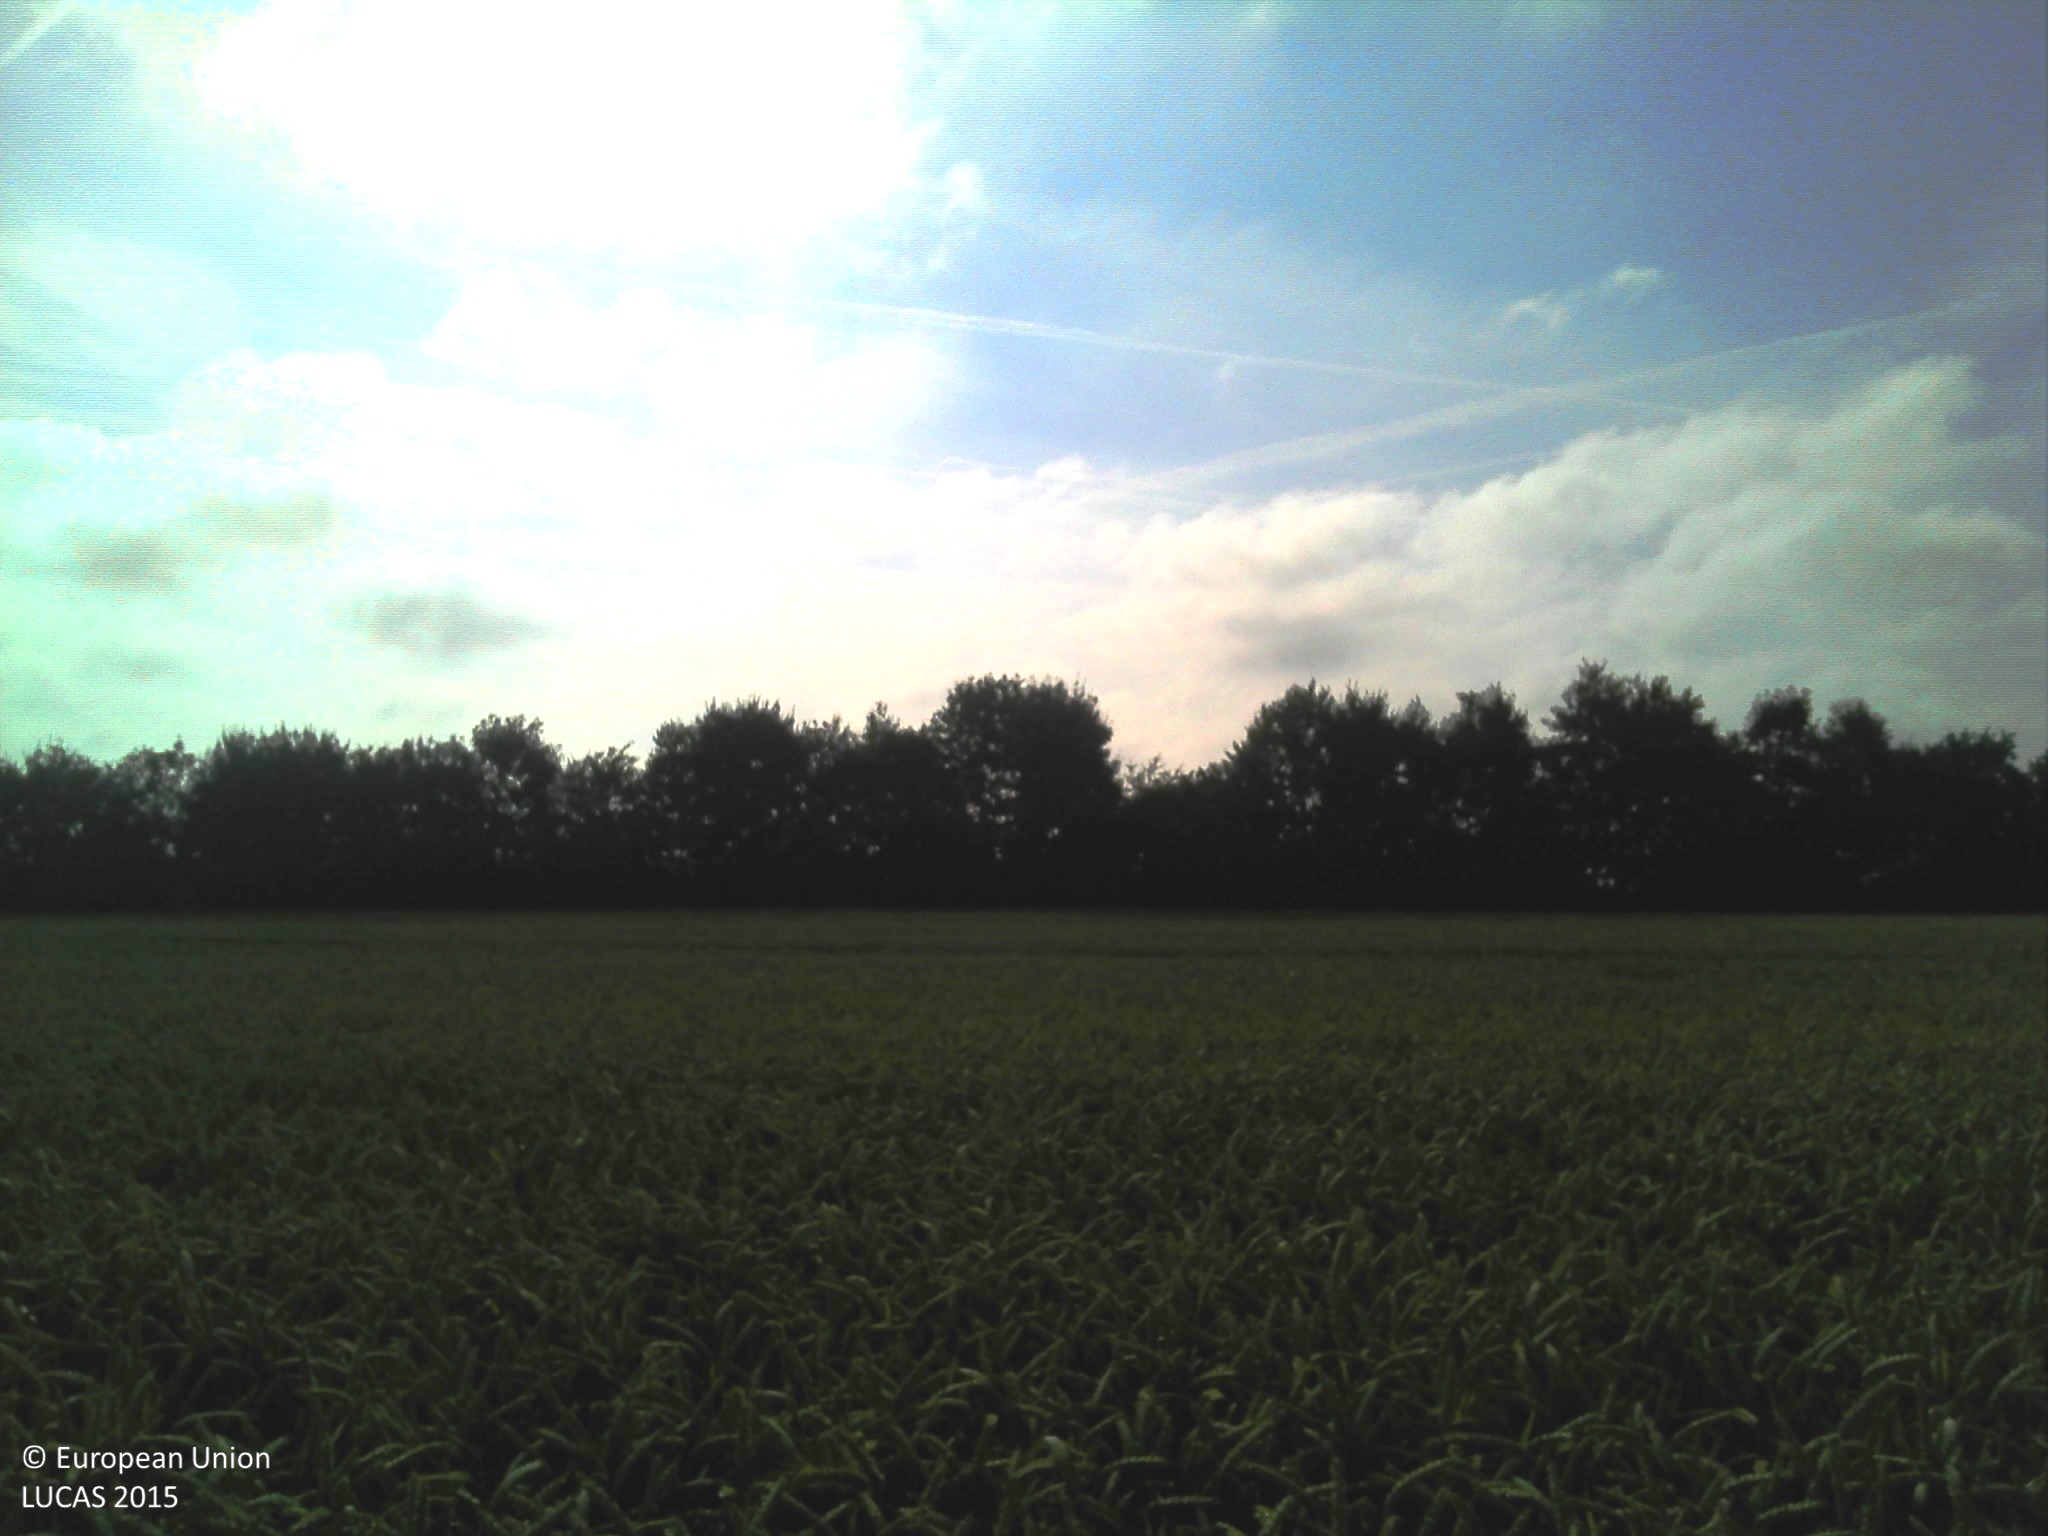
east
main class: Cropland
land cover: Common wheat
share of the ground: > 75 %
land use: Agriculture (excluding fallow land and kitchen gardens)
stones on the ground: < 10 %
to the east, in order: Common wheat; Broadleaved woodland; Ditches and canals; Maize
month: June
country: FR
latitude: 48.2020
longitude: 0.1914
